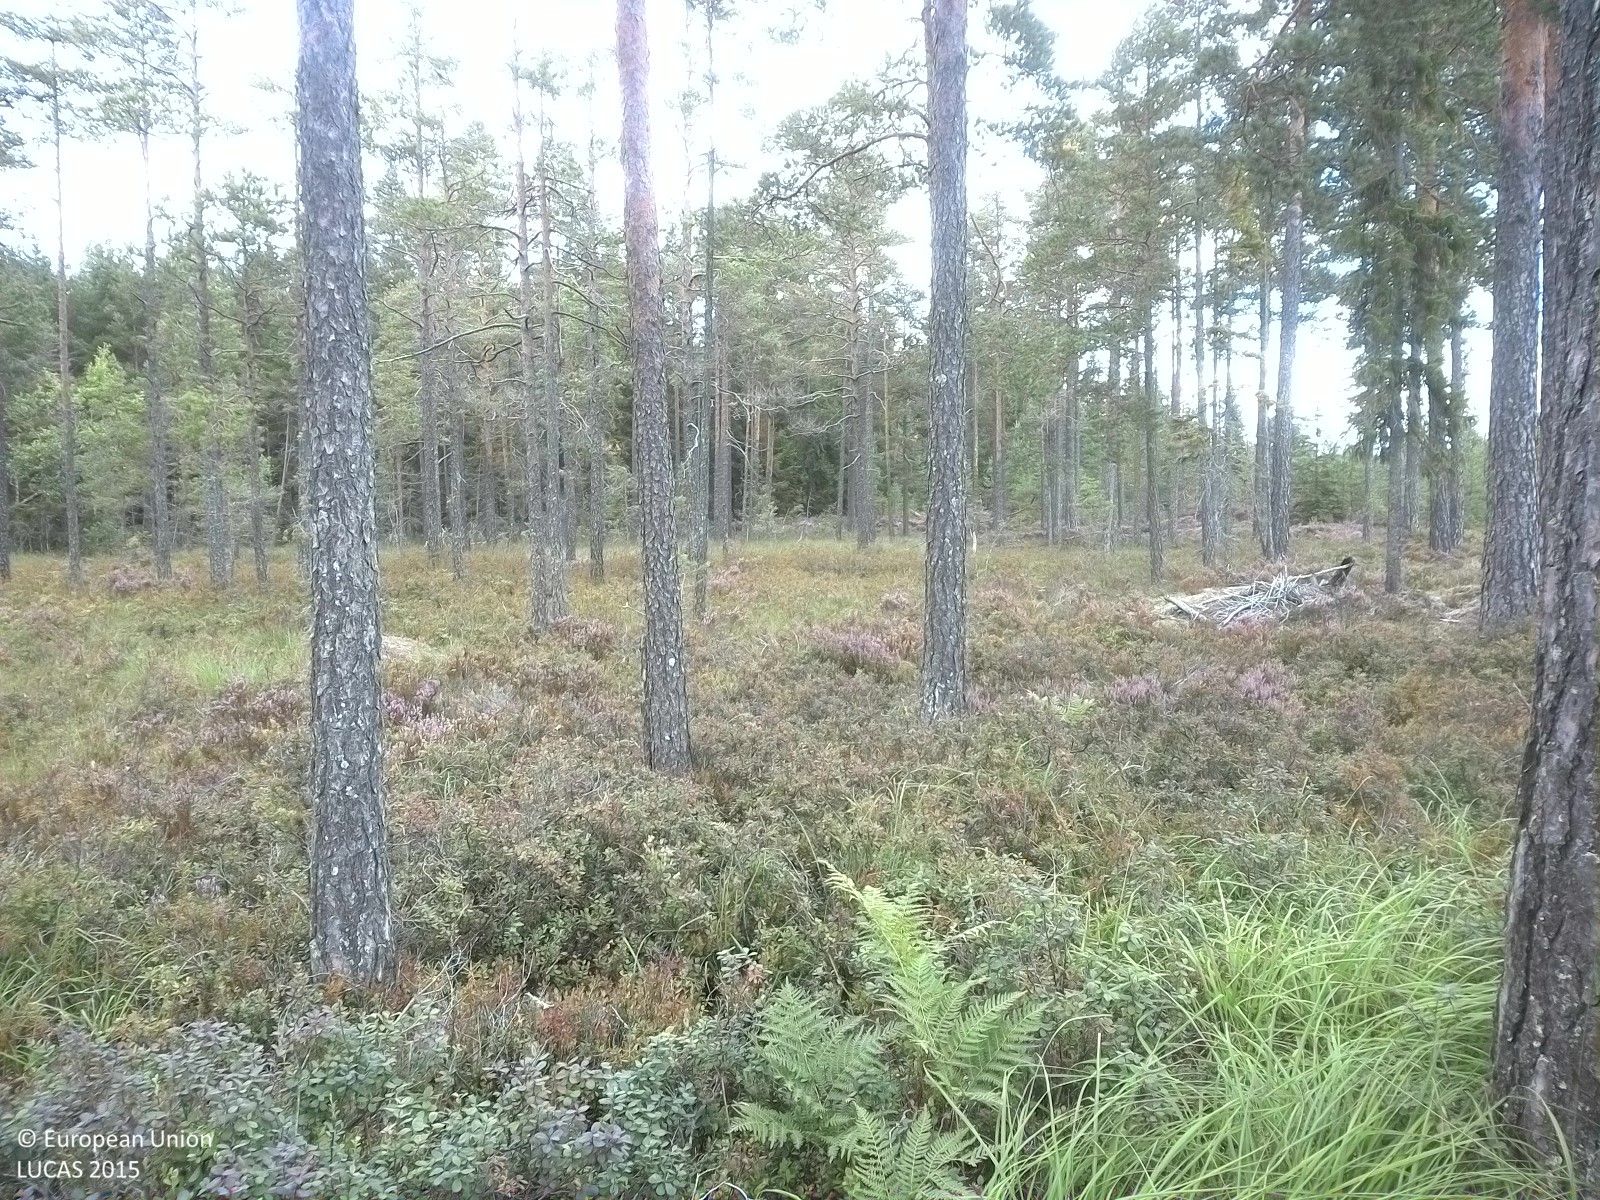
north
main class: Woodland
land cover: Pine dominated coniferous woodland
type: boreal forest
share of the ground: 25 - 50 %
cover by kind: shrubs 50 %, coniferous forest trees 25 %, lichens and mosses 15 %, herbaceous plants 10 %
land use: Forestry
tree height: > 5 m
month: August
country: SE
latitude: 58.9862
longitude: 15.6132
